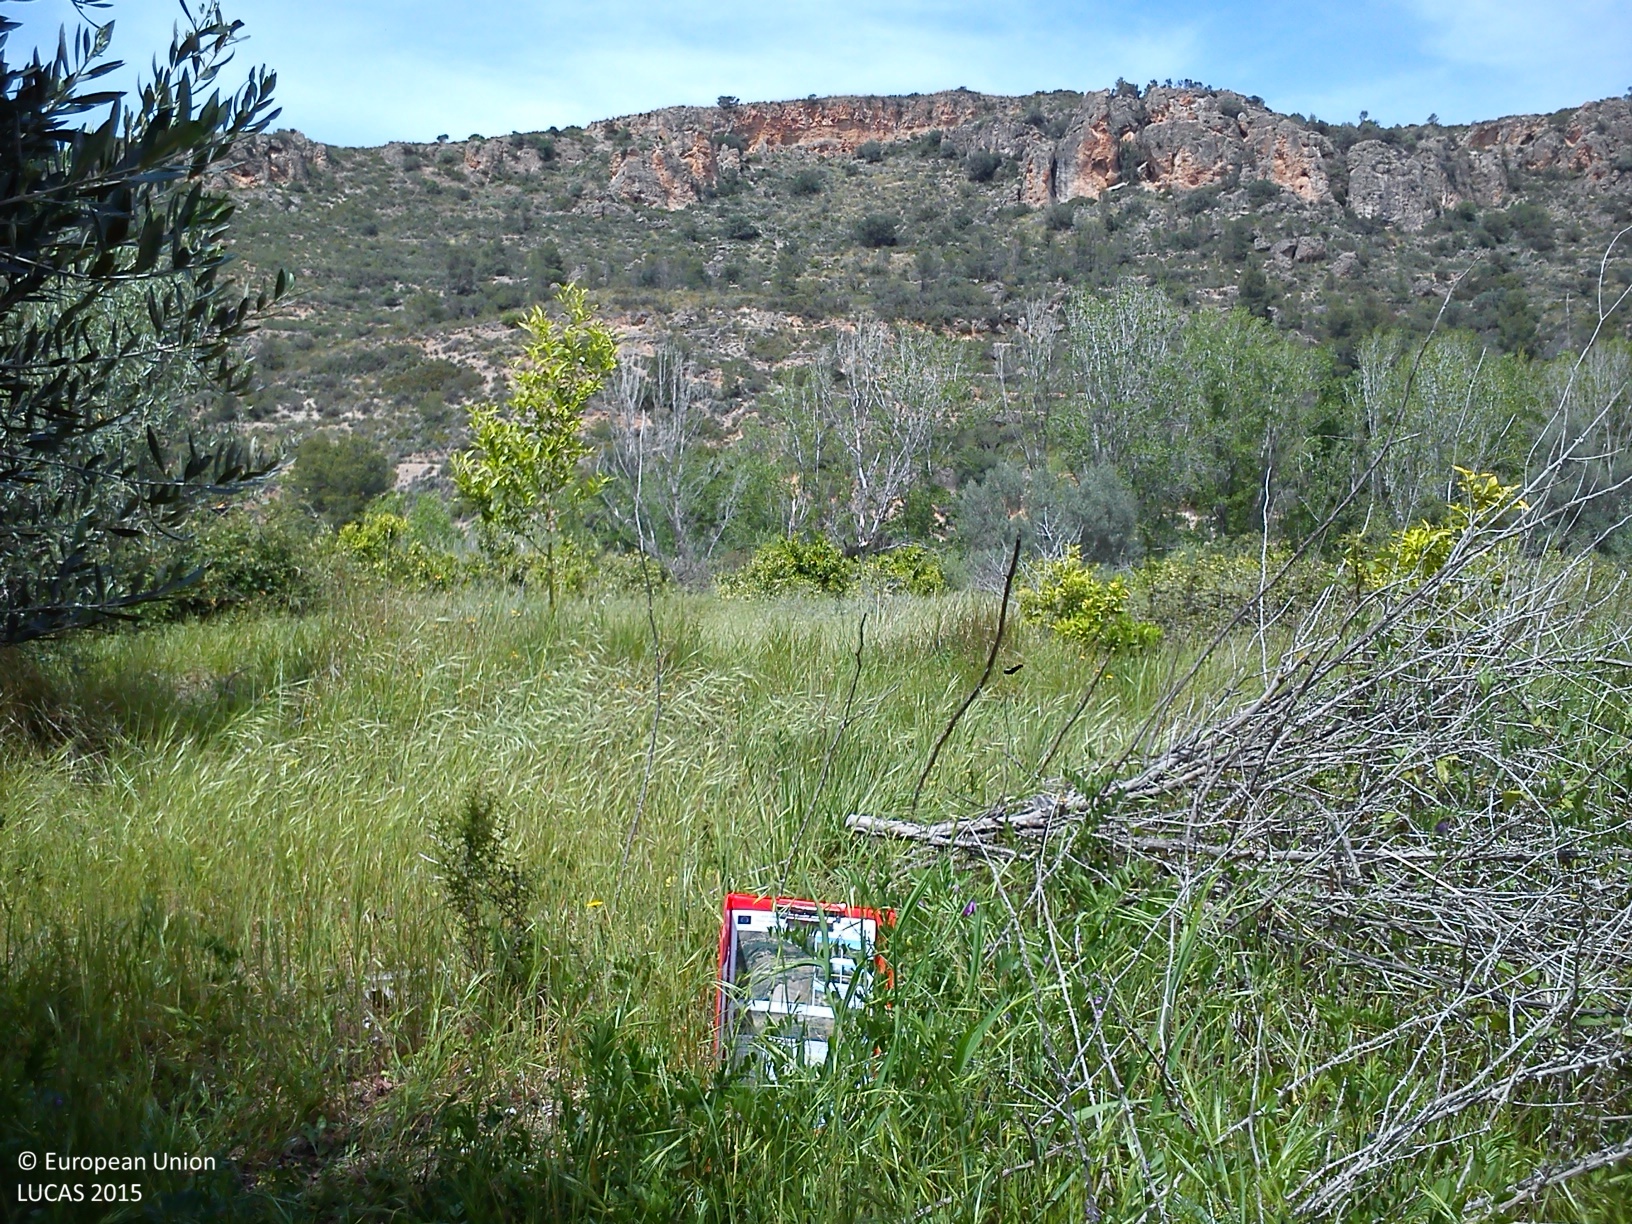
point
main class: Grassland
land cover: Grassland with sparse tree/shrub cover
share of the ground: > 75 %
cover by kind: herbaceous plants 95 %, broadleaved forest trees 5 %
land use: Abandoned areas
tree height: < 5 m
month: April
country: ES
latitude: 39.3562
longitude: -0.6625
